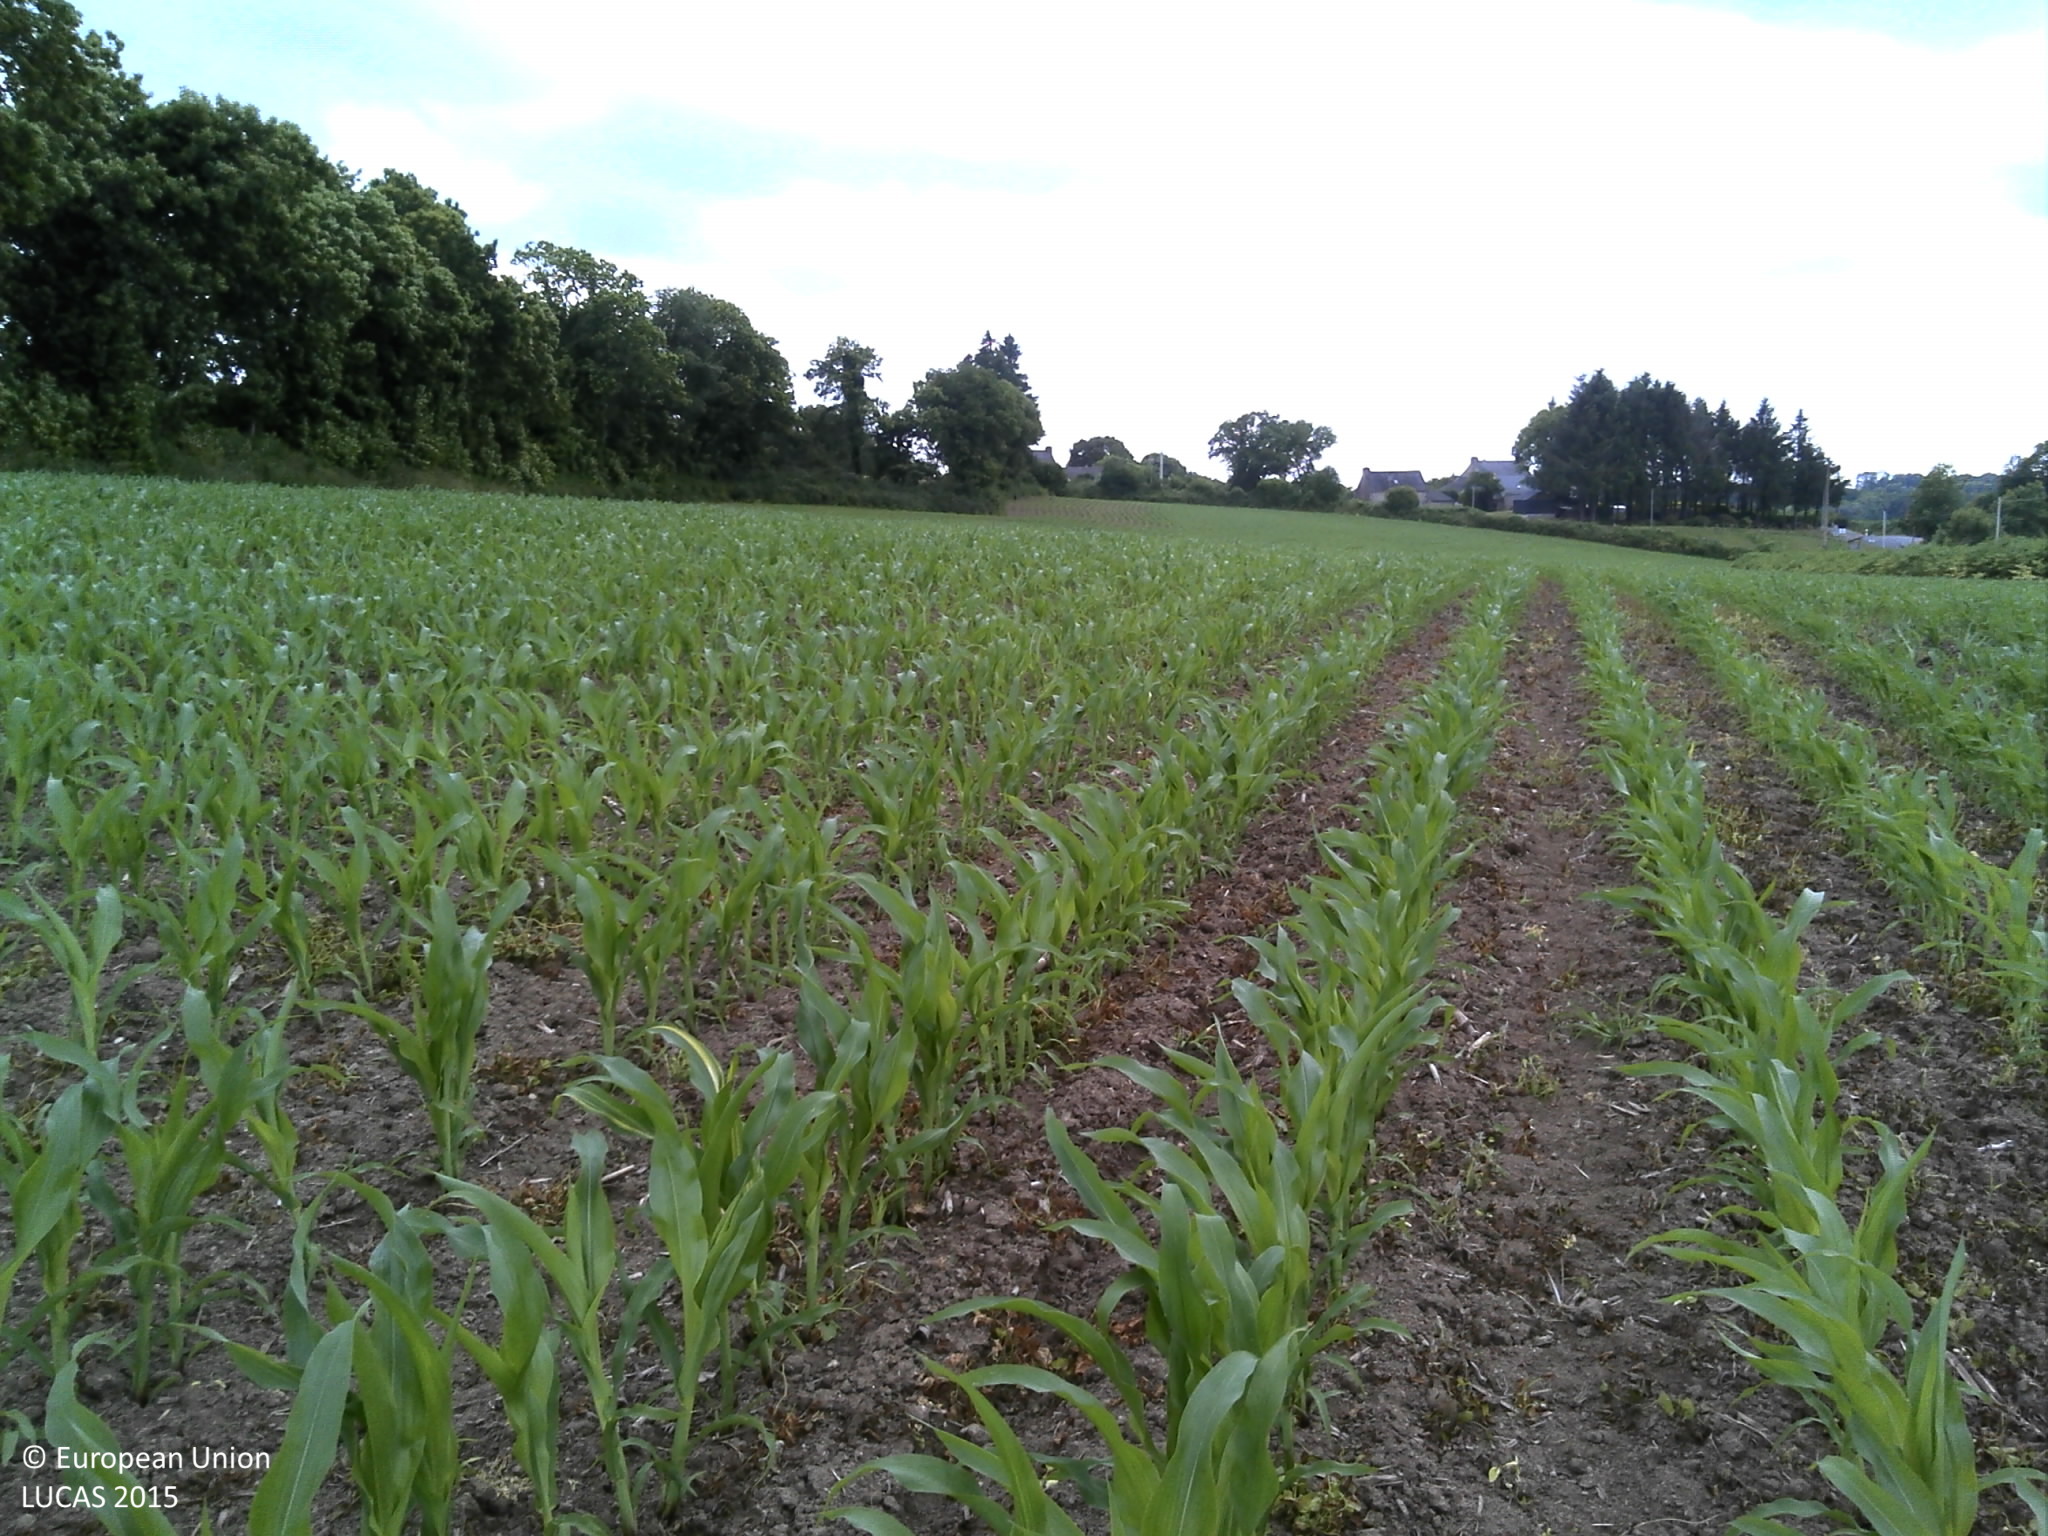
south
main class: Cropland
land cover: Maize
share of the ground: 50 - 75 %
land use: Agriculture (excluding fallow land and kitchen gardens)
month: June
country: FR
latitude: 47.9752
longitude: -3.6223
